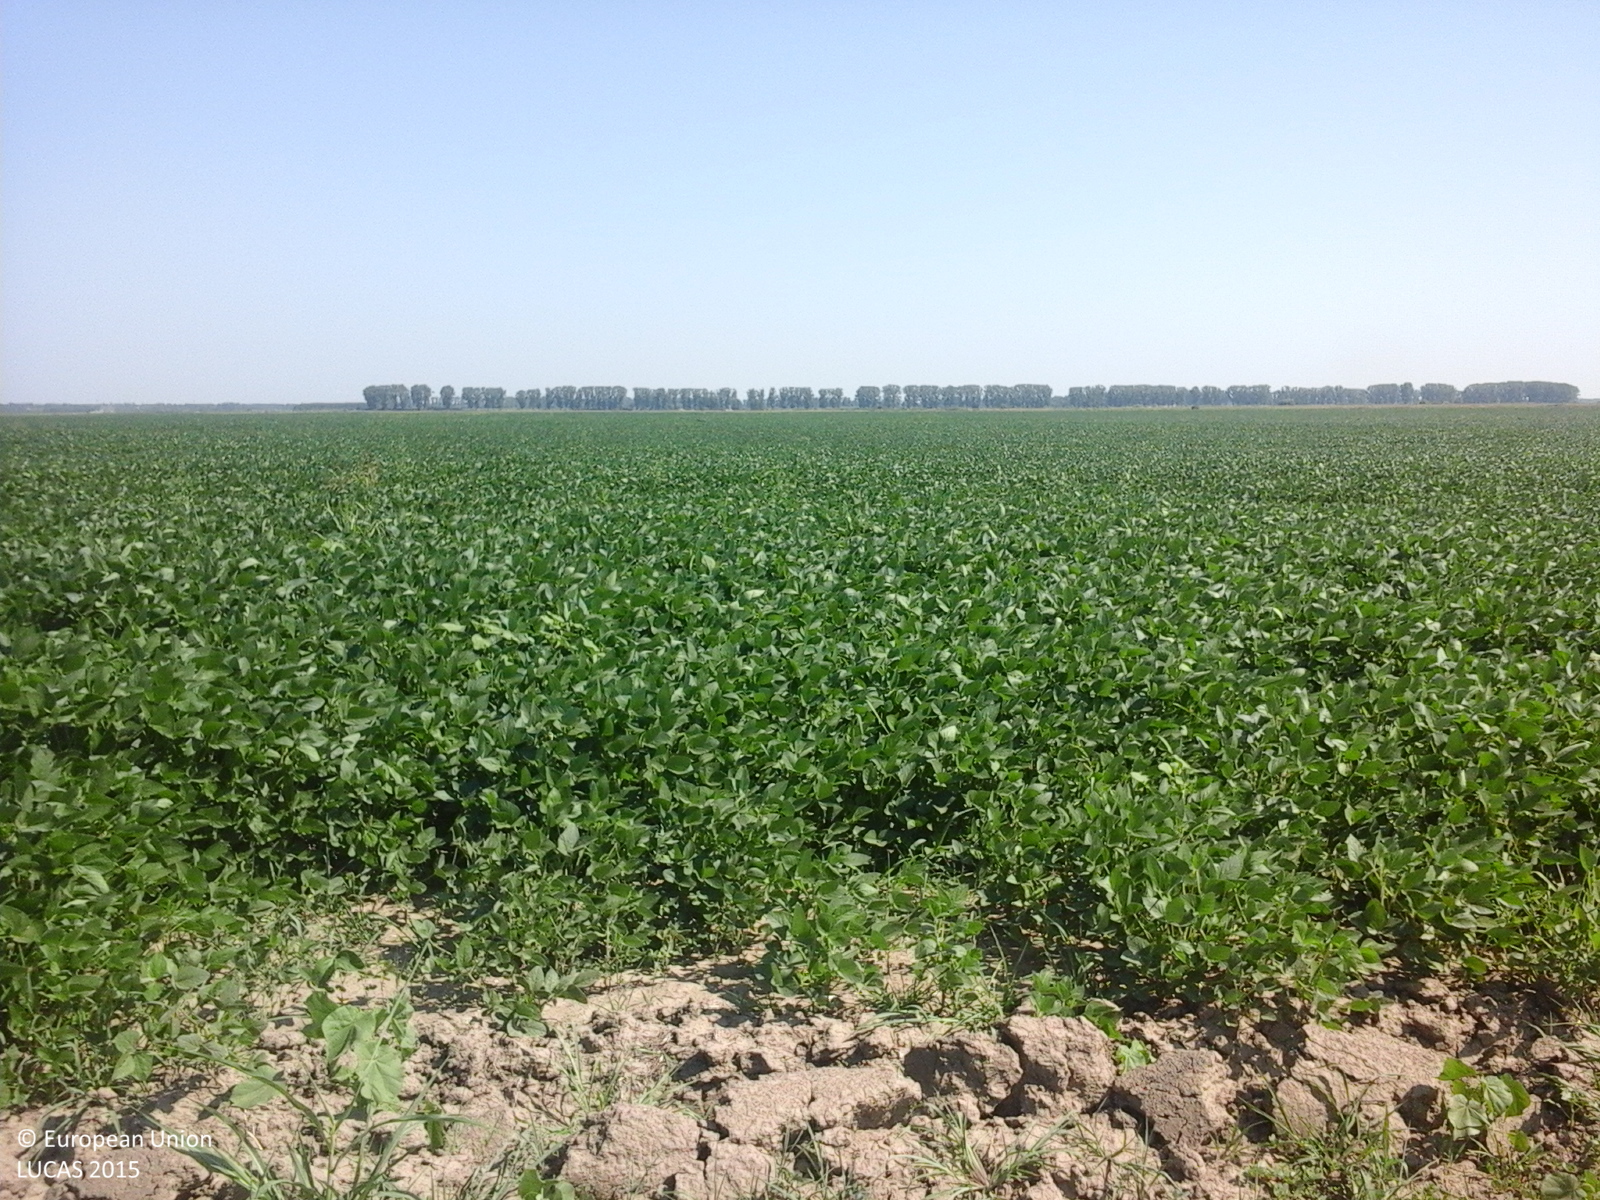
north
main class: Cropland
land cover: Maize
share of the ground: > 75 %
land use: Agriculture (excluding fallow land and kitchen gardens)
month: July
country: RO
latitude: 44.1606
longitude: 27.0451
